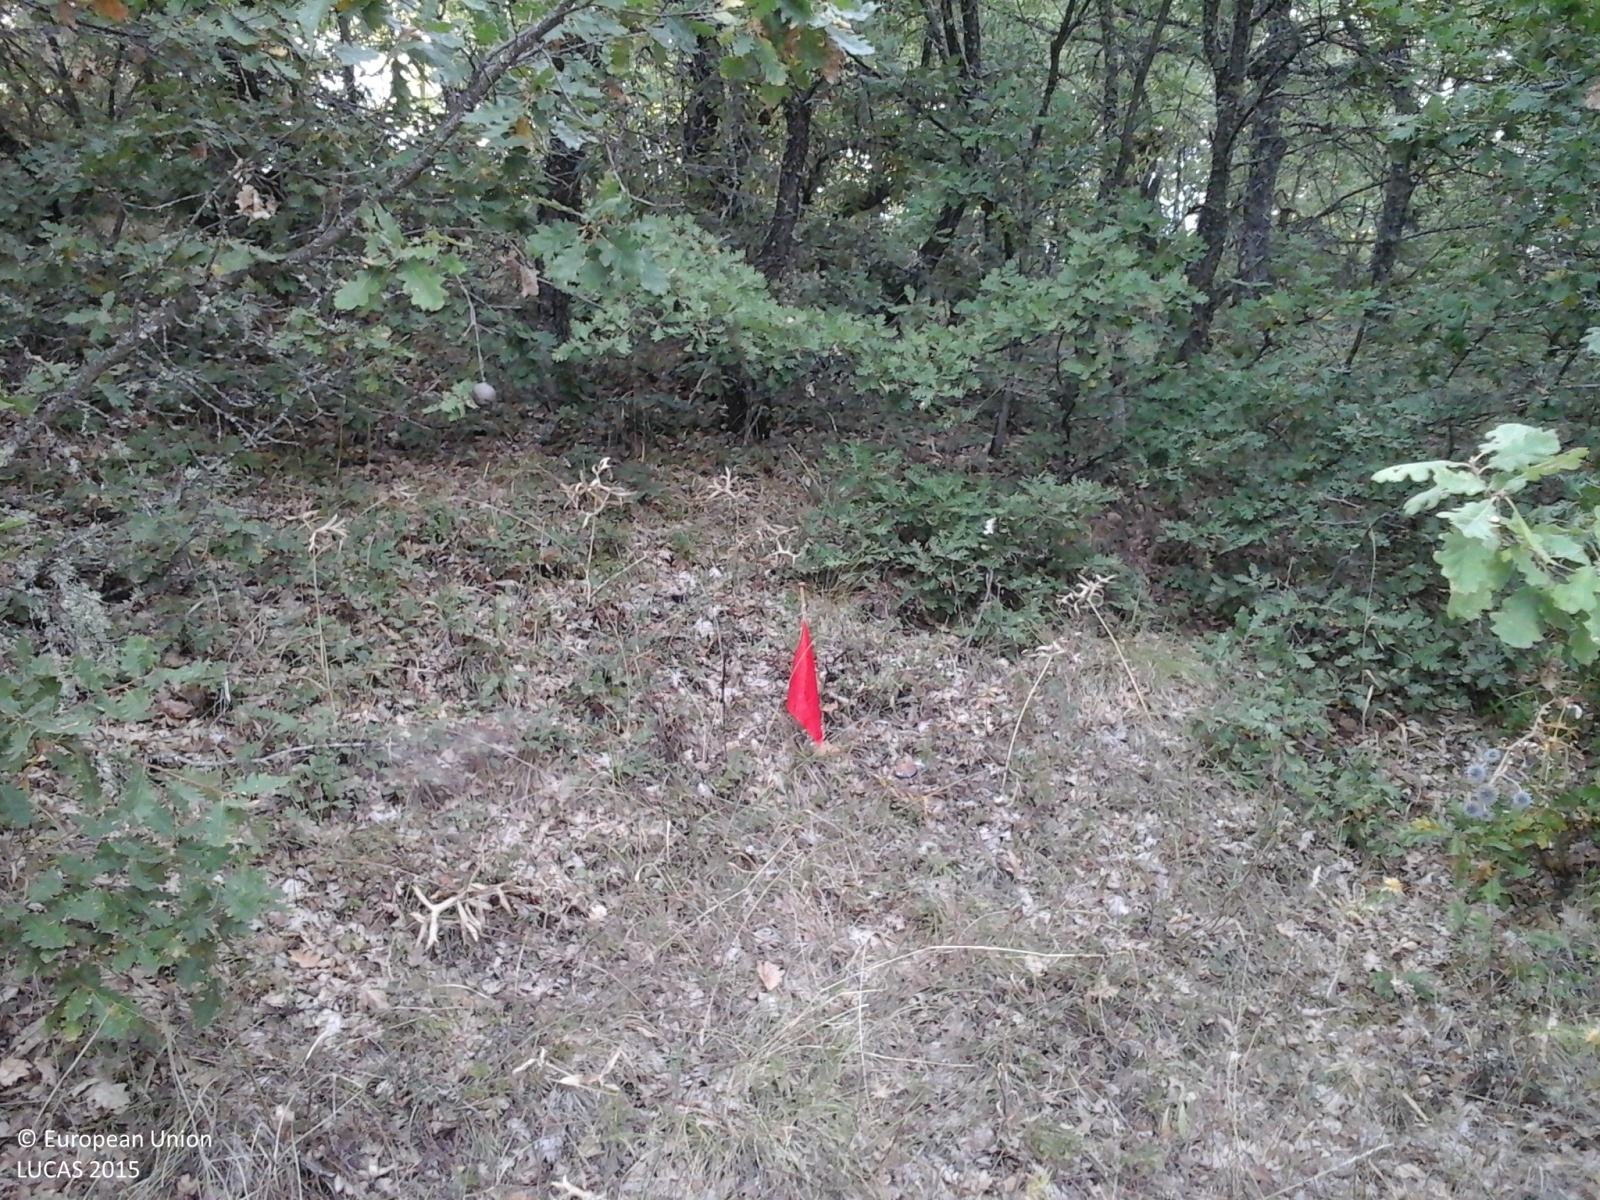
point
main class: Woodland
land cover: Broadleaved woodland
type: thermophilous deciduous forest
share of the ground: > 75 %
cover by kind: broadleaved forest trees 85 %, shrubs 5 %, herbaceous plants 5 %, unconsolidated bare surface 5 %
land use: Forestry
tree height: > 5 m
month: September
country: GR
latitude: 40.1606
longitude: 21.2929
